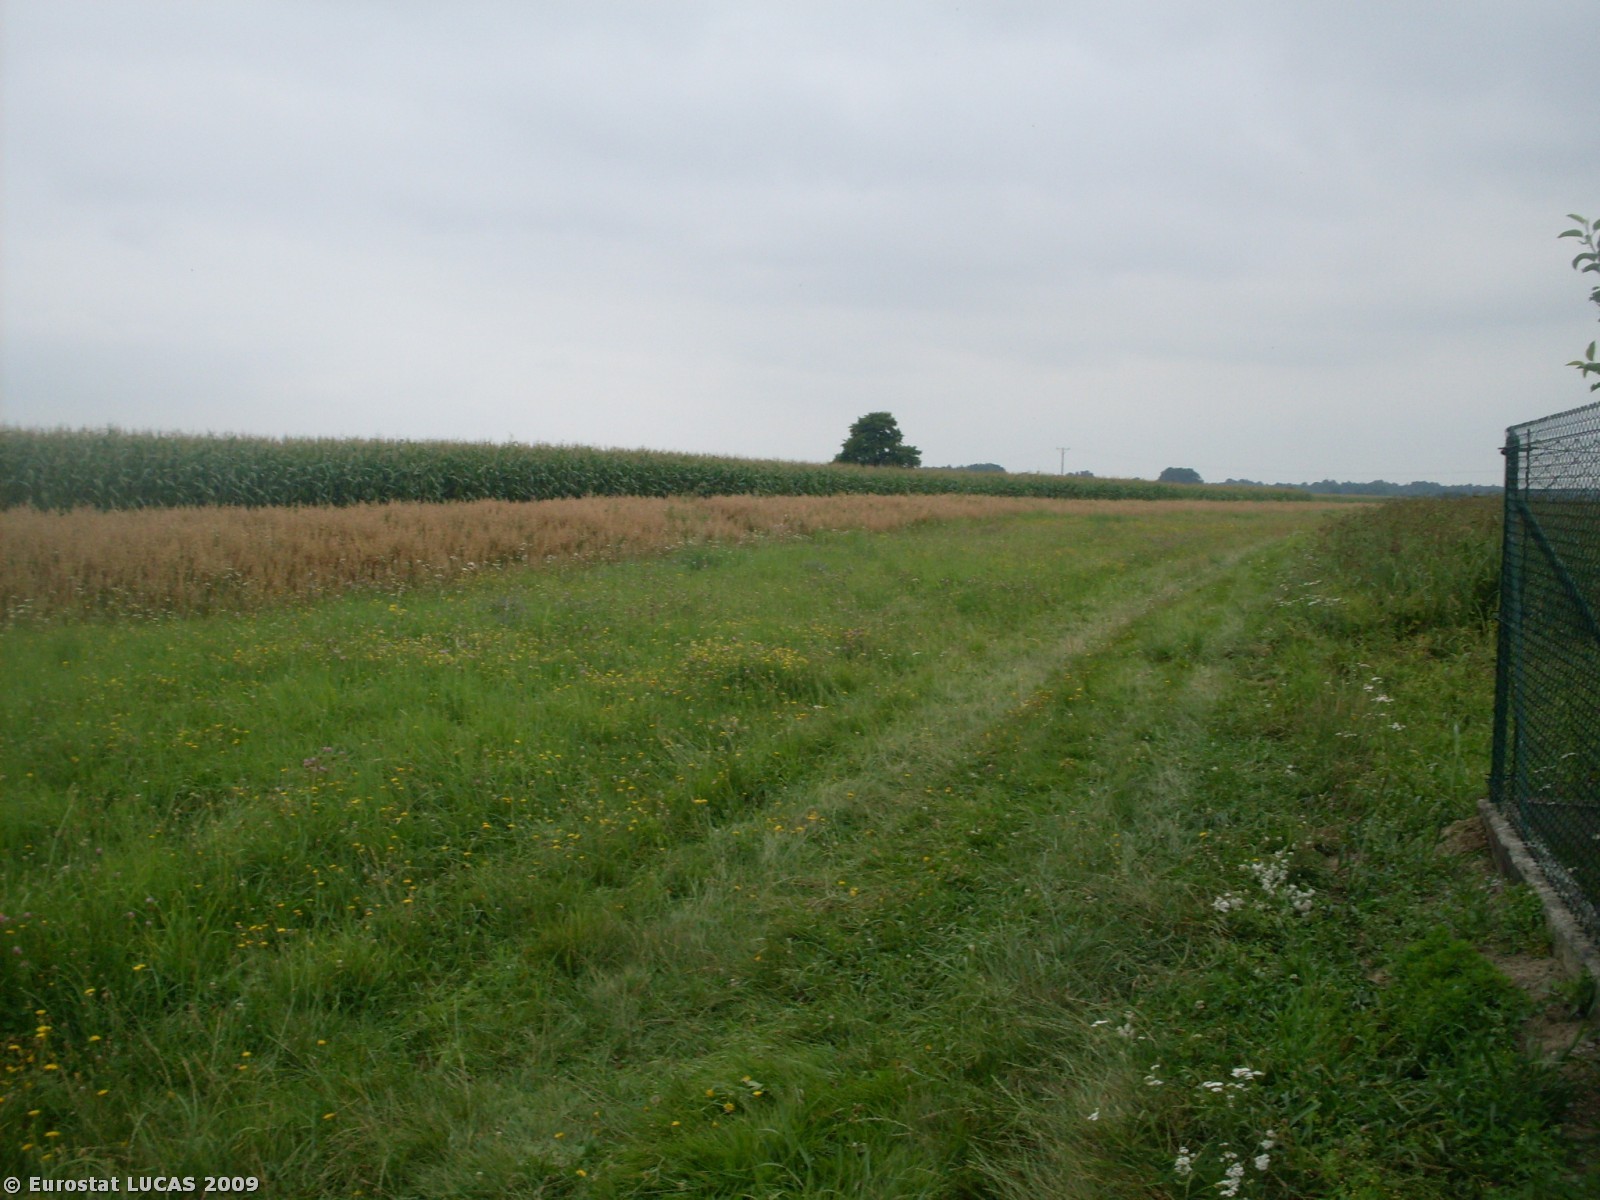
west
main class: Cropland
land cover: Other fruit trees and berries
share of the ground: 50 - 75 %
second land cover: Grassland with sparse tree/shrub cover
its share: > 75 %
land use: Agriculture (excluding fallow land and kitchen gardens)
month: August
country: PL
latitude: 50.0781
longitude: 20.7020
